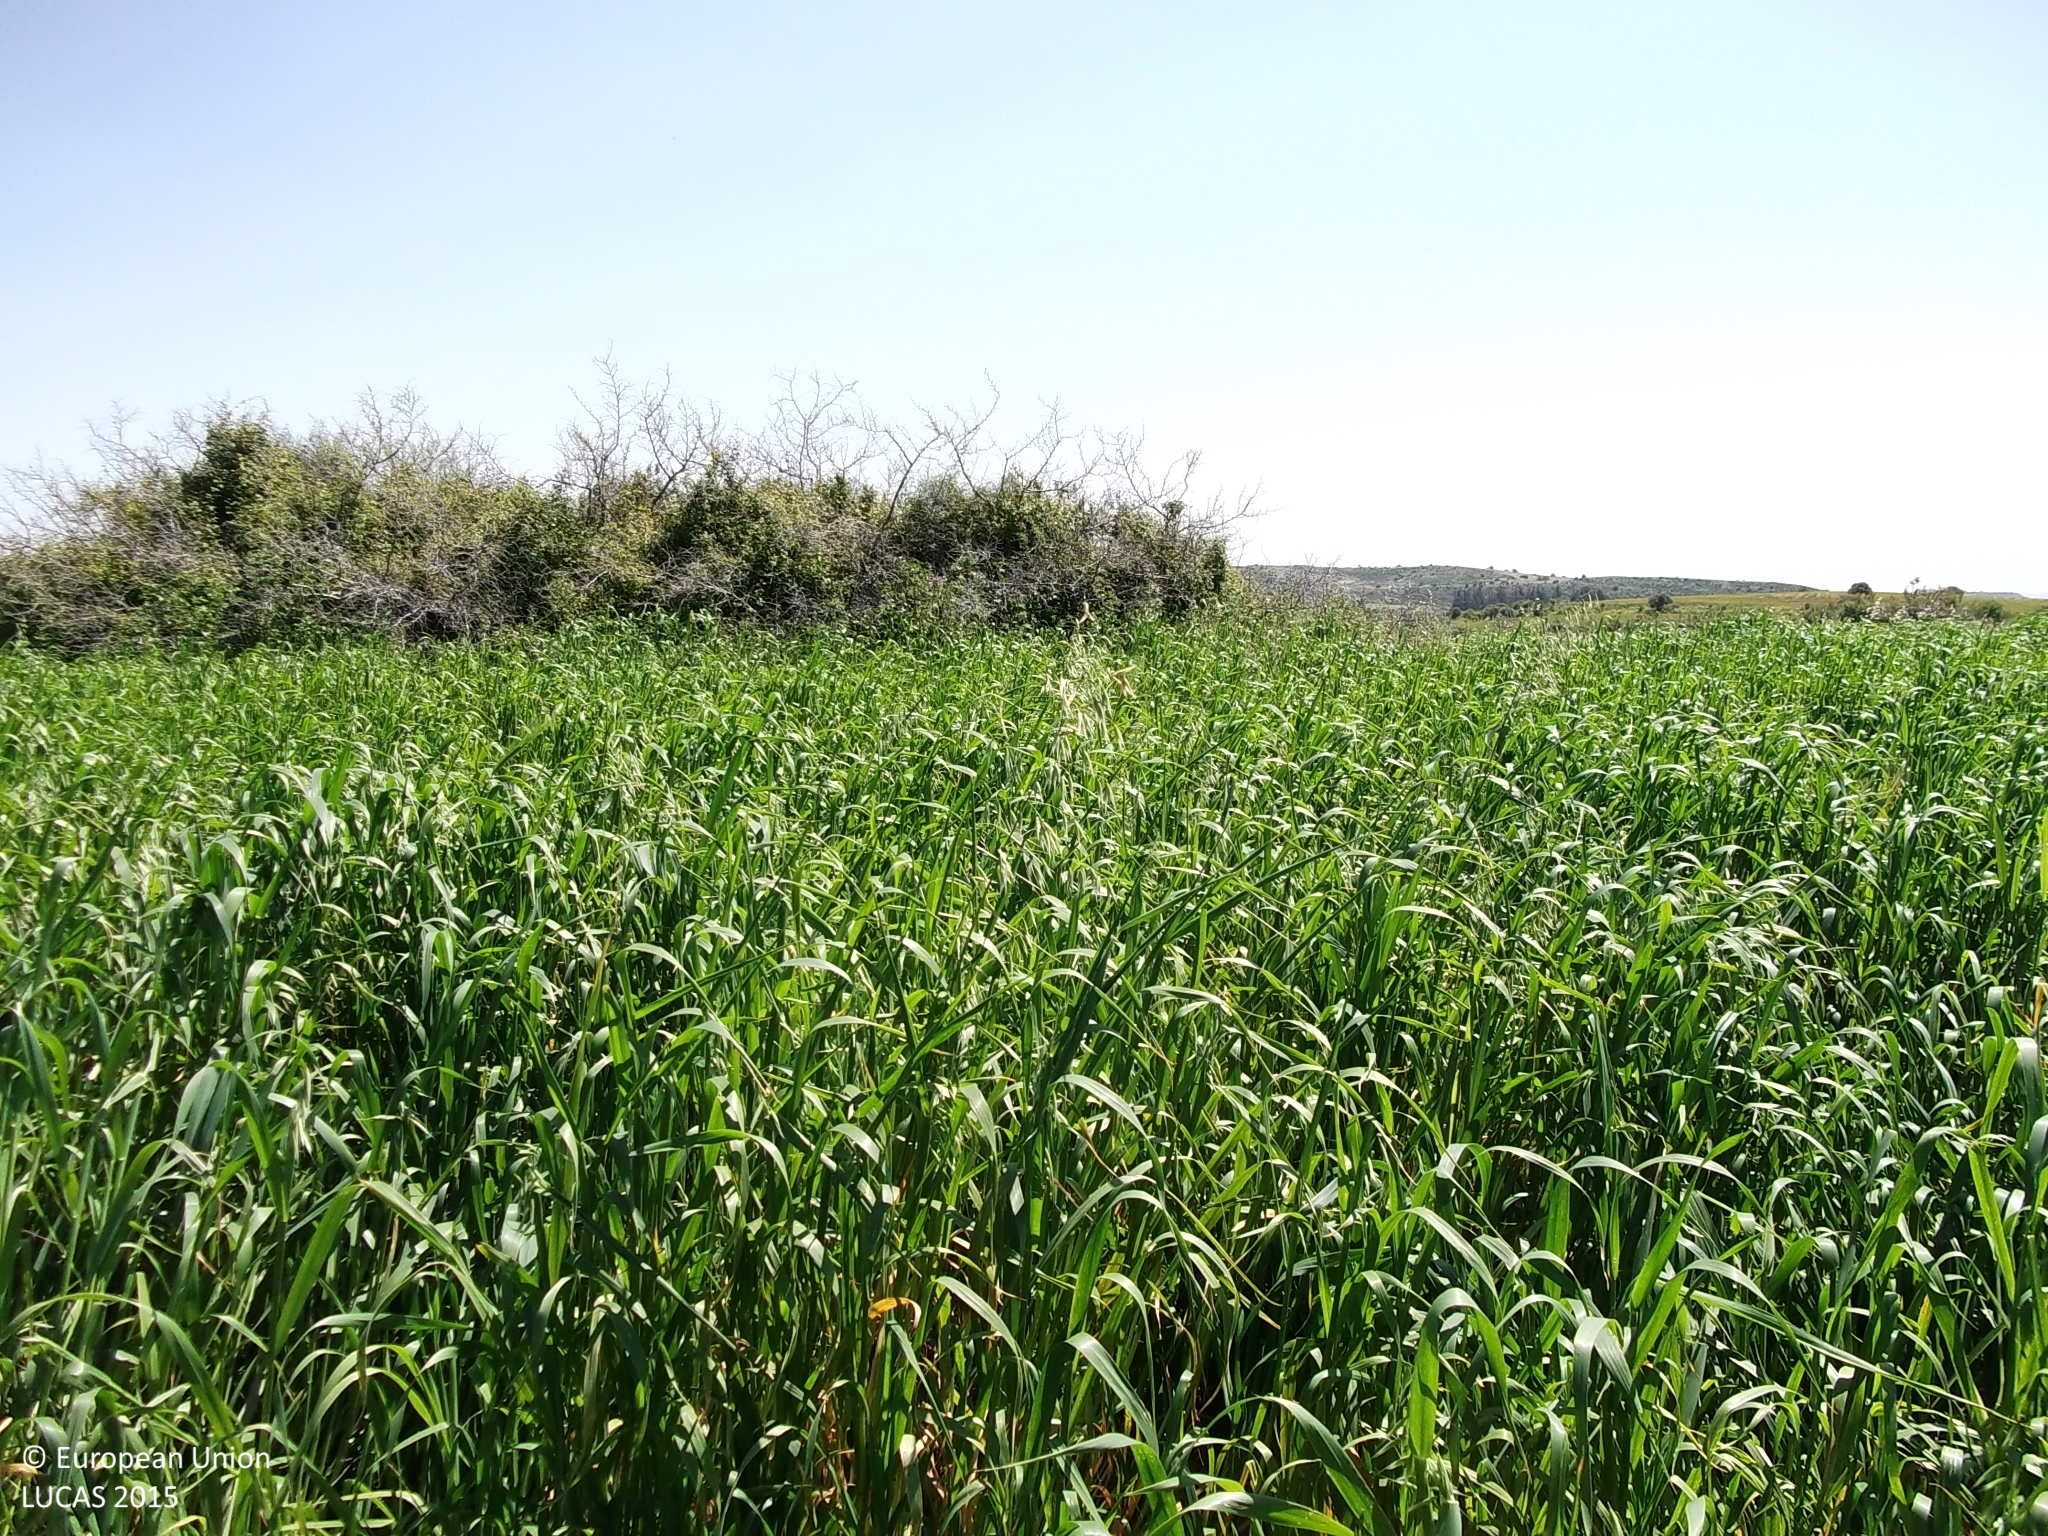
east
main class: Cropland
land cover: Oats
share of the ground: > 75 %
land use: Agriculture (excluding fallow land and kitchen gardens)
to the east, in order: Oats; Single bushes/trees; Barley; Mixed cereals for fodder; Paved roads, cycling and walking lanes; Mixed cereals for fodder
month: April
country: CY
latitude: 34.8179
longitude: 33.4160
